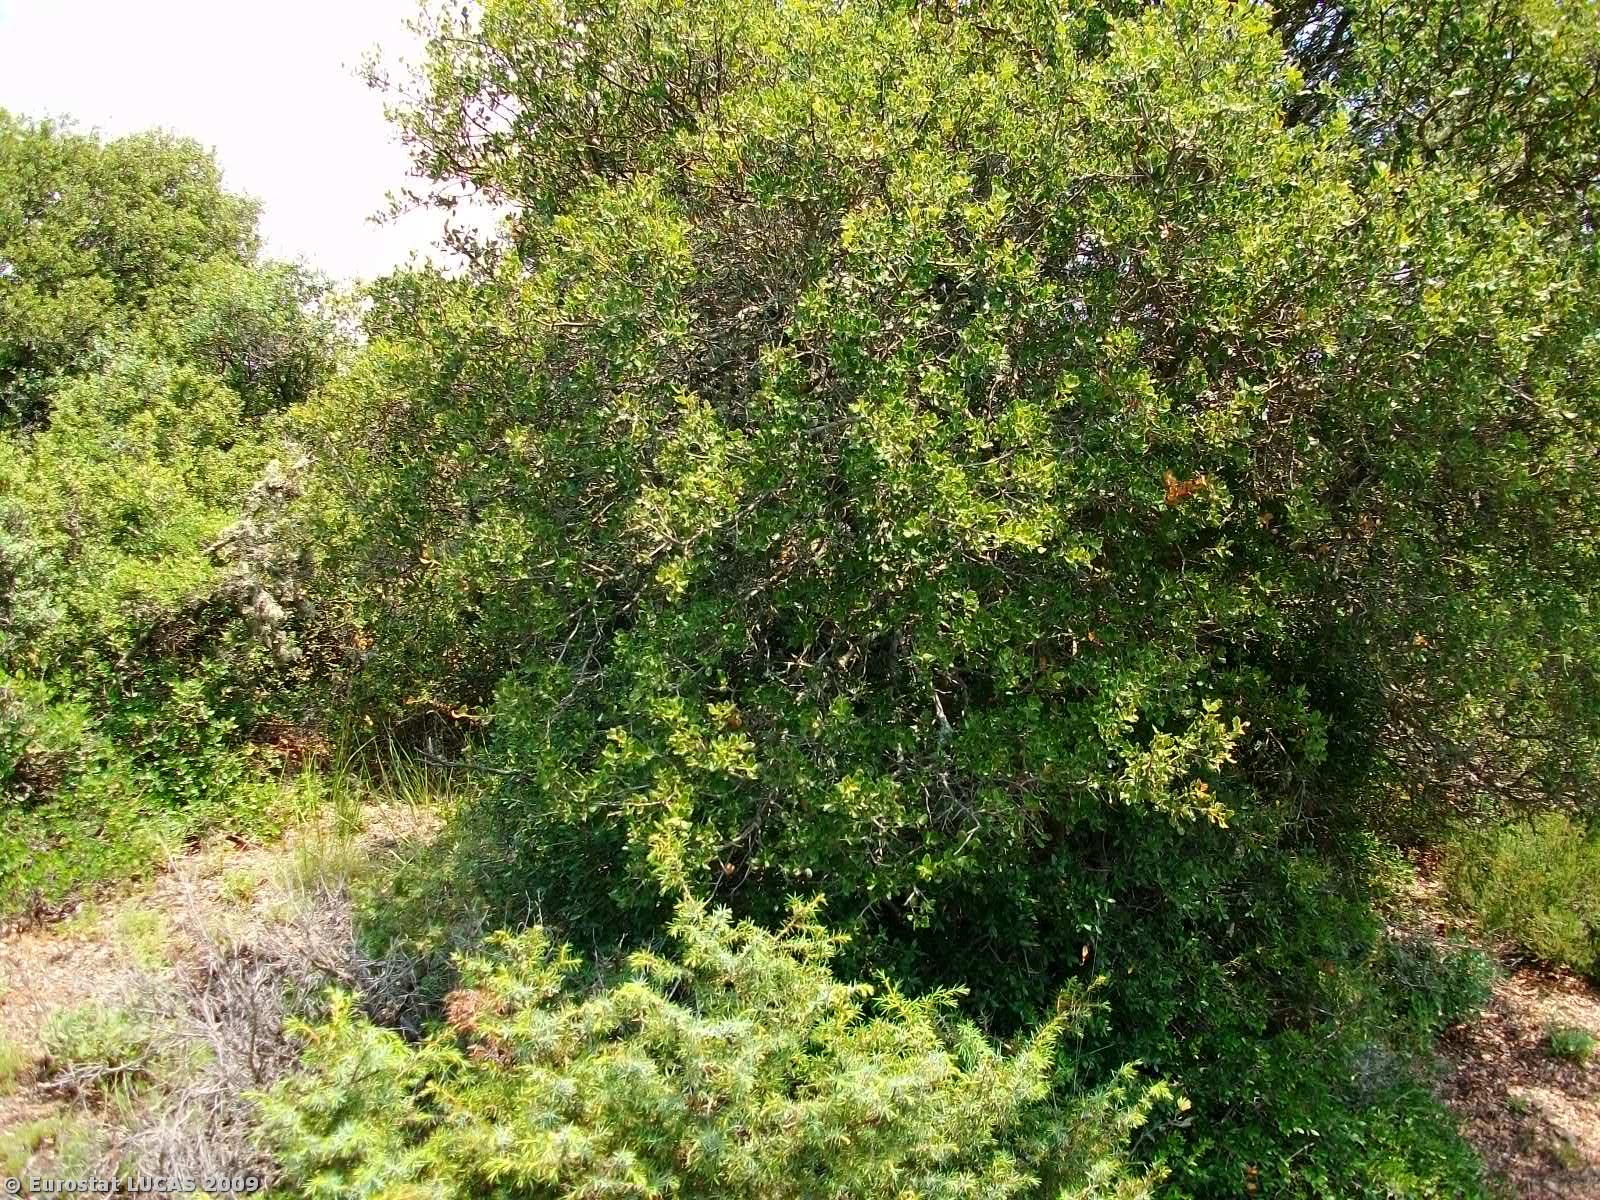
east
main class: Shrubland
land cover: Shrubland without tree cover
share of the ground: 50 - 75 %
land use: Unused
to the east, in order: Shrubland without tree cover; Mixed woodland; Shrubland without tree cover
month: May
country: GR
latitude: 40.9556
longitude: 25.5068
